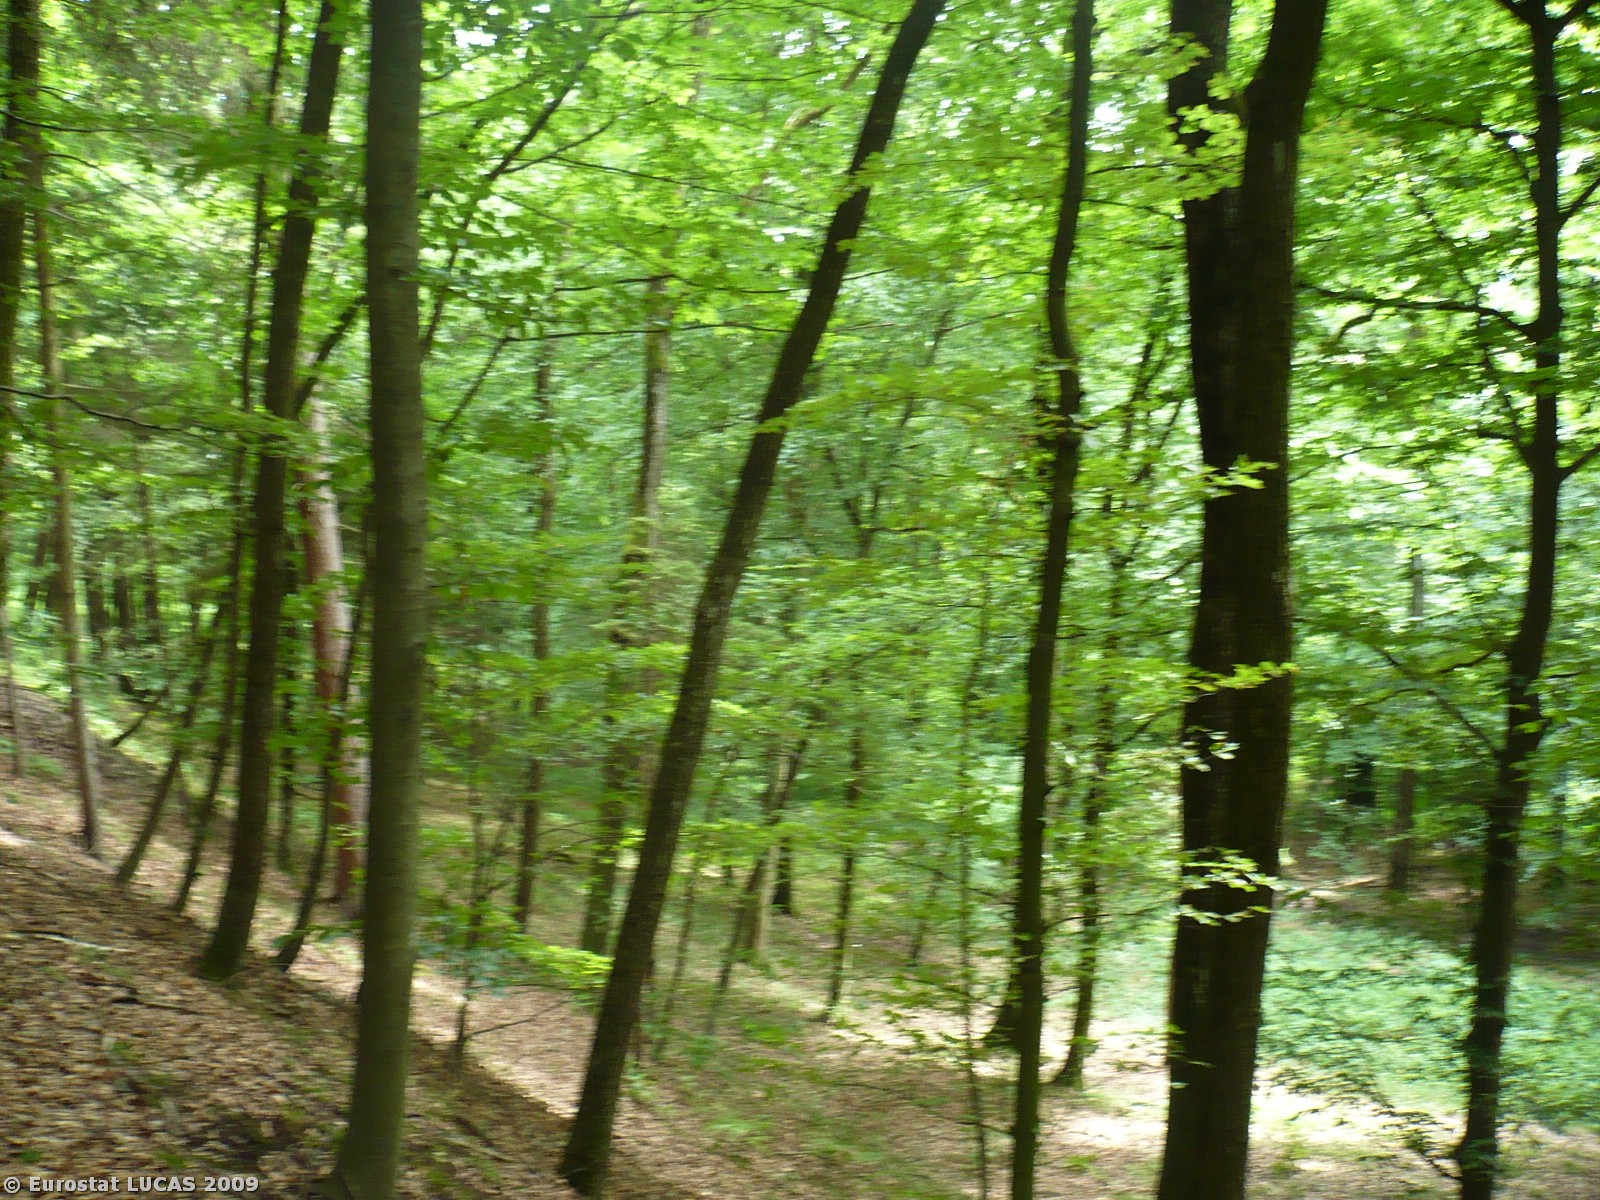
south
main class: Woodland
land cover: Broadleaved woodland
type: mesophytic deciduous forest
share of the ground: > 75 %
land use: Forestry
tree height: > 5 m
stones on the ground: < 10 %
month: June
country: SI
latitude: 46.5777
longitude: 16.0417
